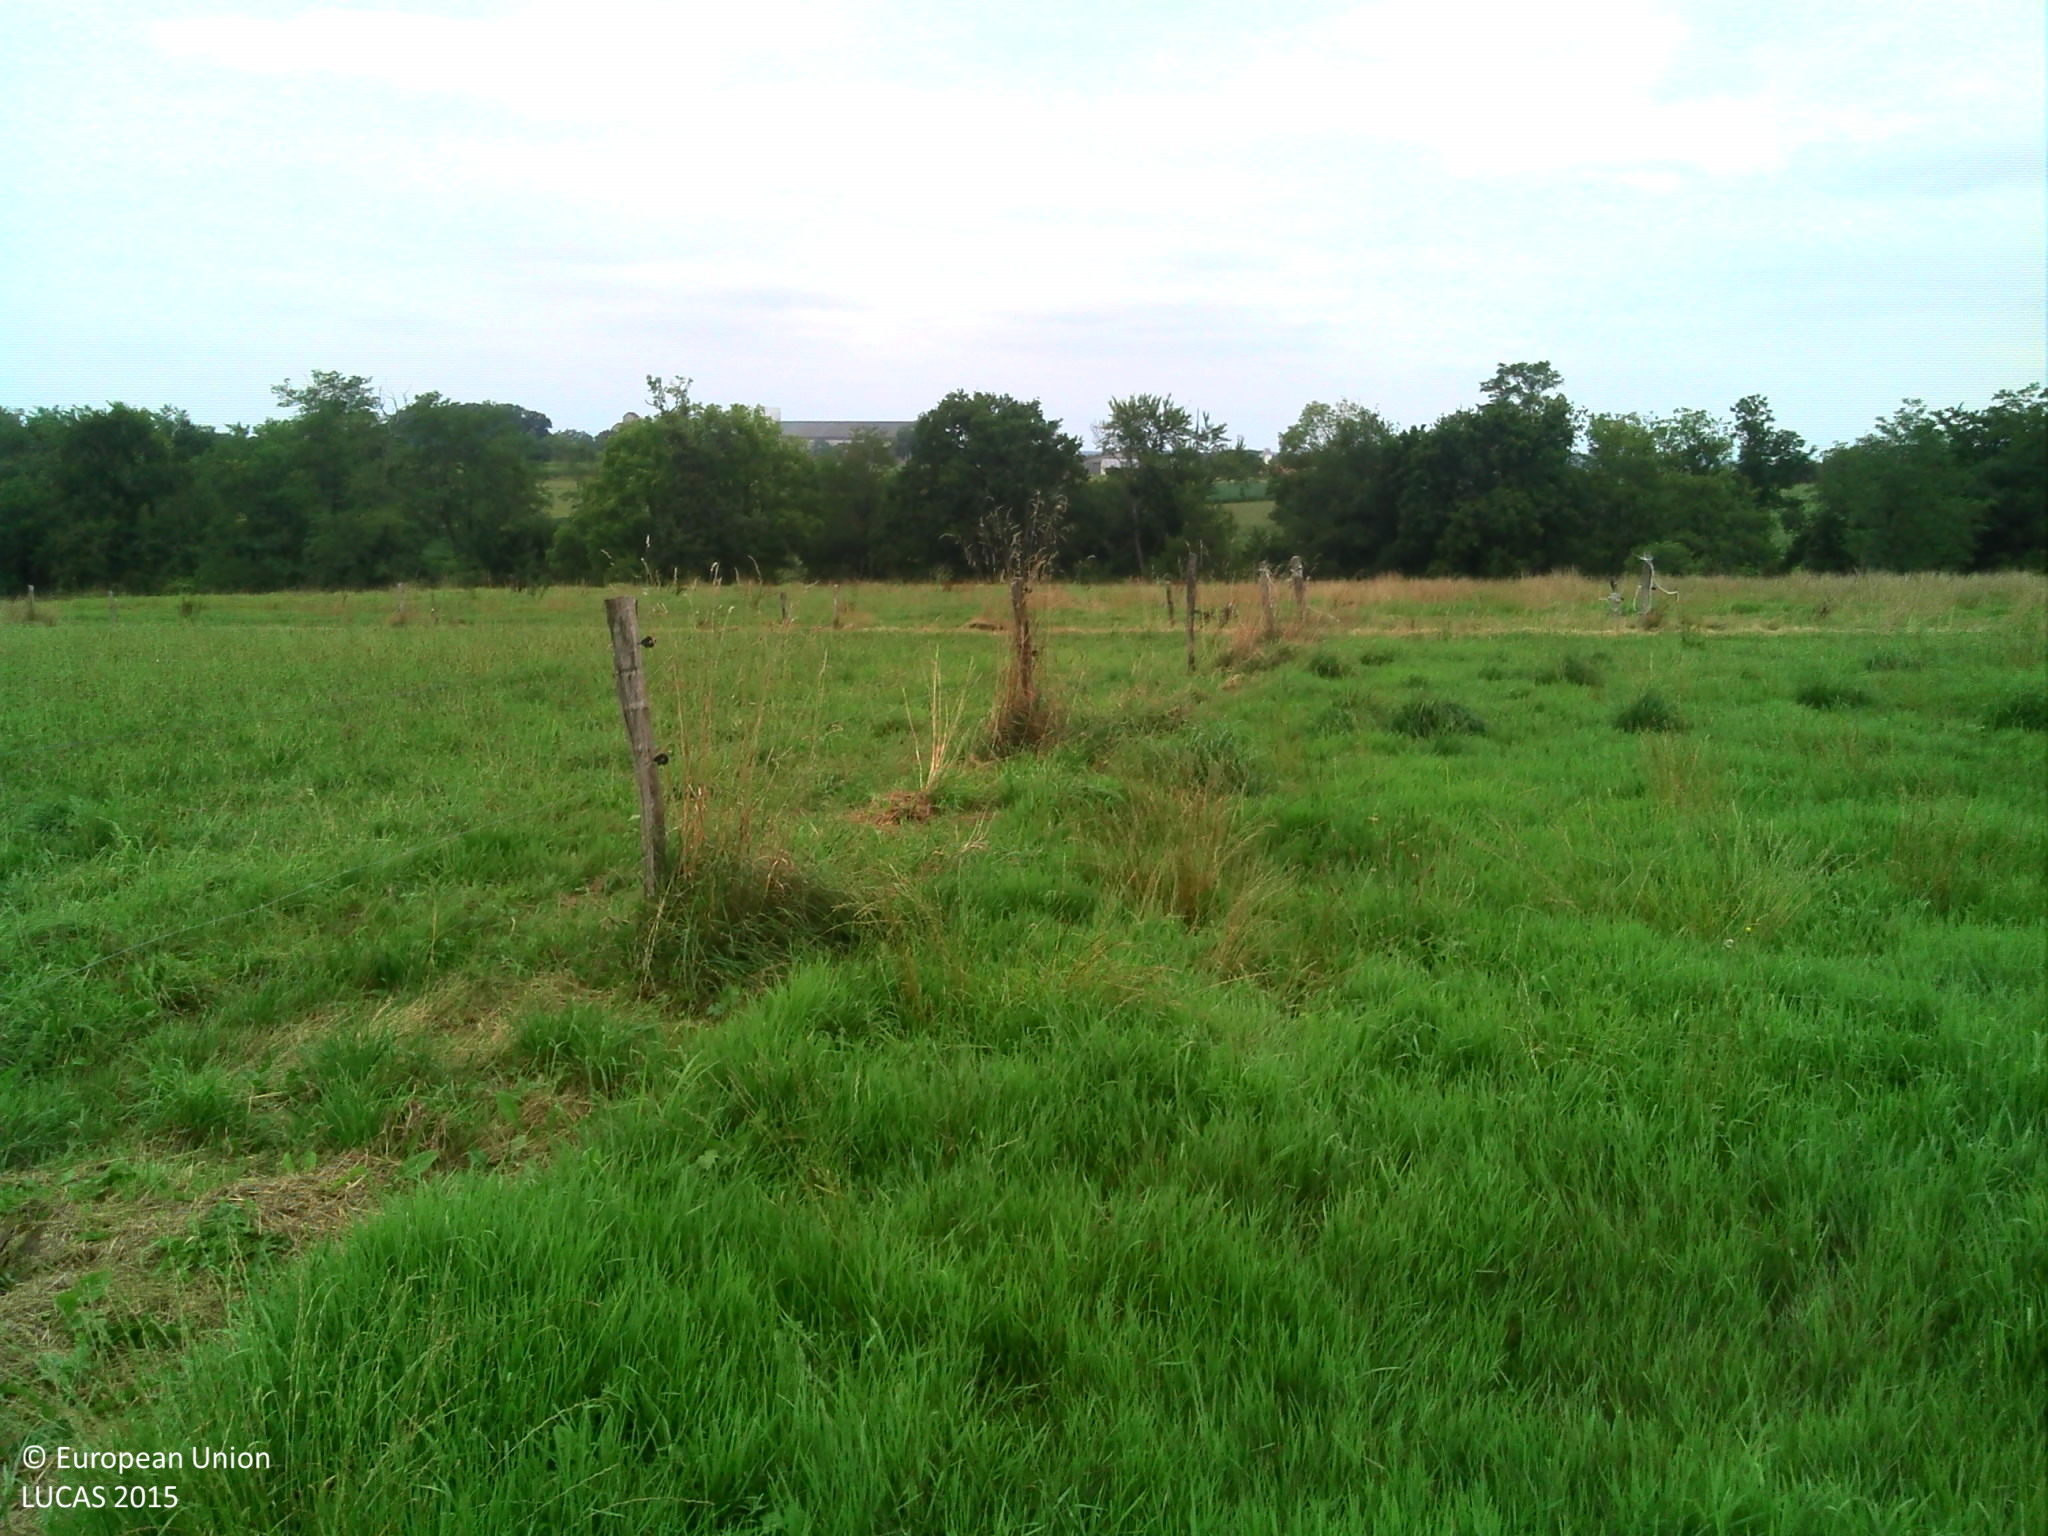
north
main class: Grassland
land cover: Grassland without tree/shrub cover
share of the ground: > 75 %
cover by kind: herbaceous plants 100 %
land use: Agriculture (excluding fallow land and kitchen gardens)
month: August
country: FR
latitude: 43.4976
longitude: -1.1078
